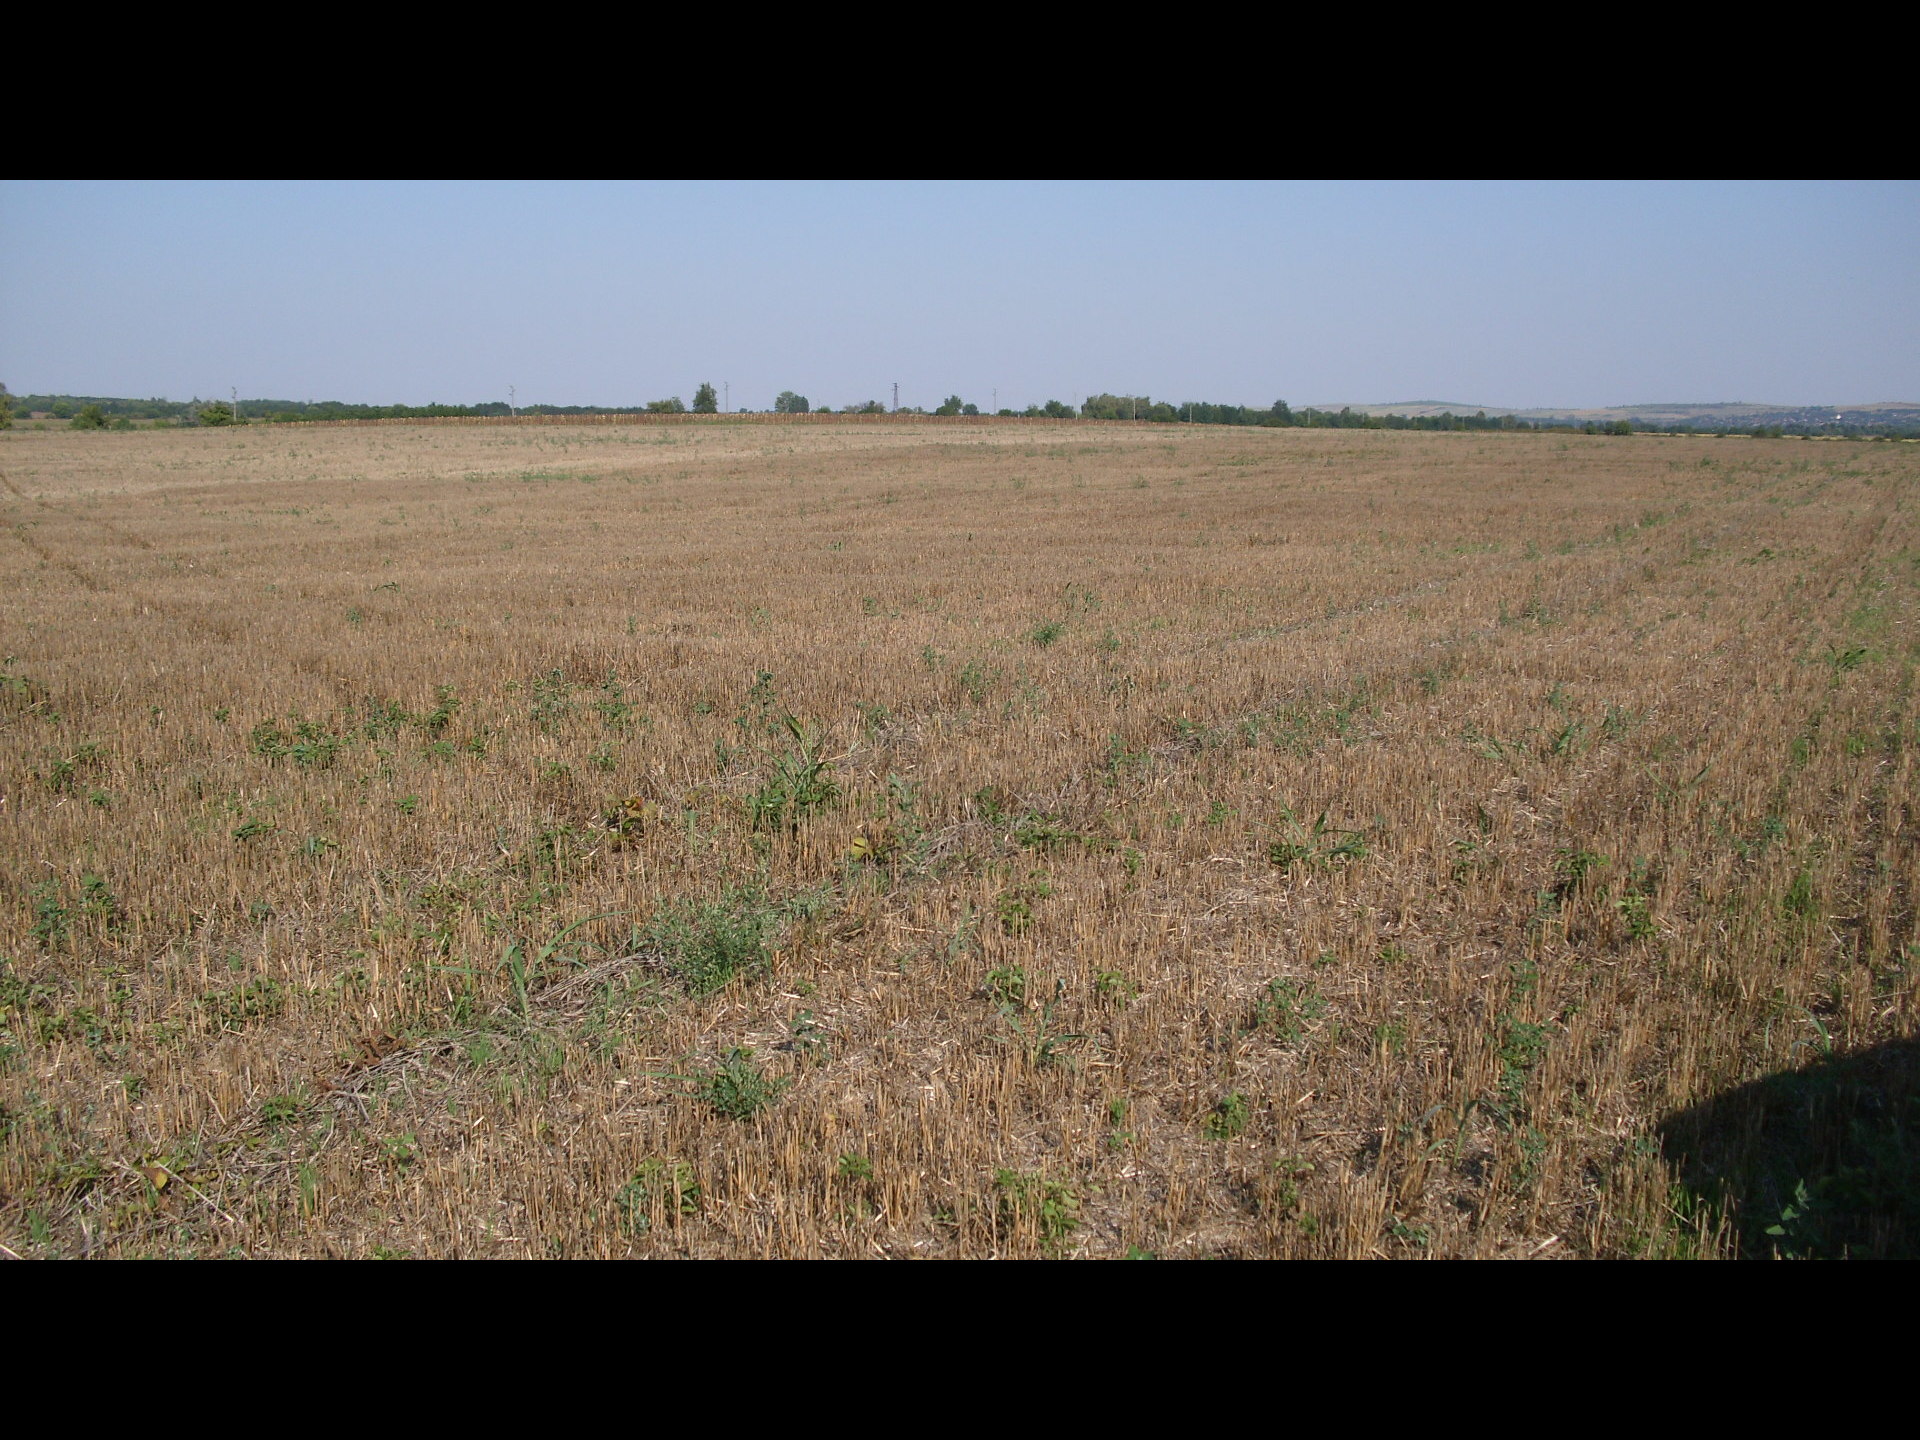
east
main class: Cropland
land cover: Common wheat
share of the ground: 50 - 75 %
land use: Agriculture (excluding fallow land and kitchen gardens)
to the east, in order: Common wheat
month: August
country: BG
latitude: 44.1145
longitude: 22.6954
